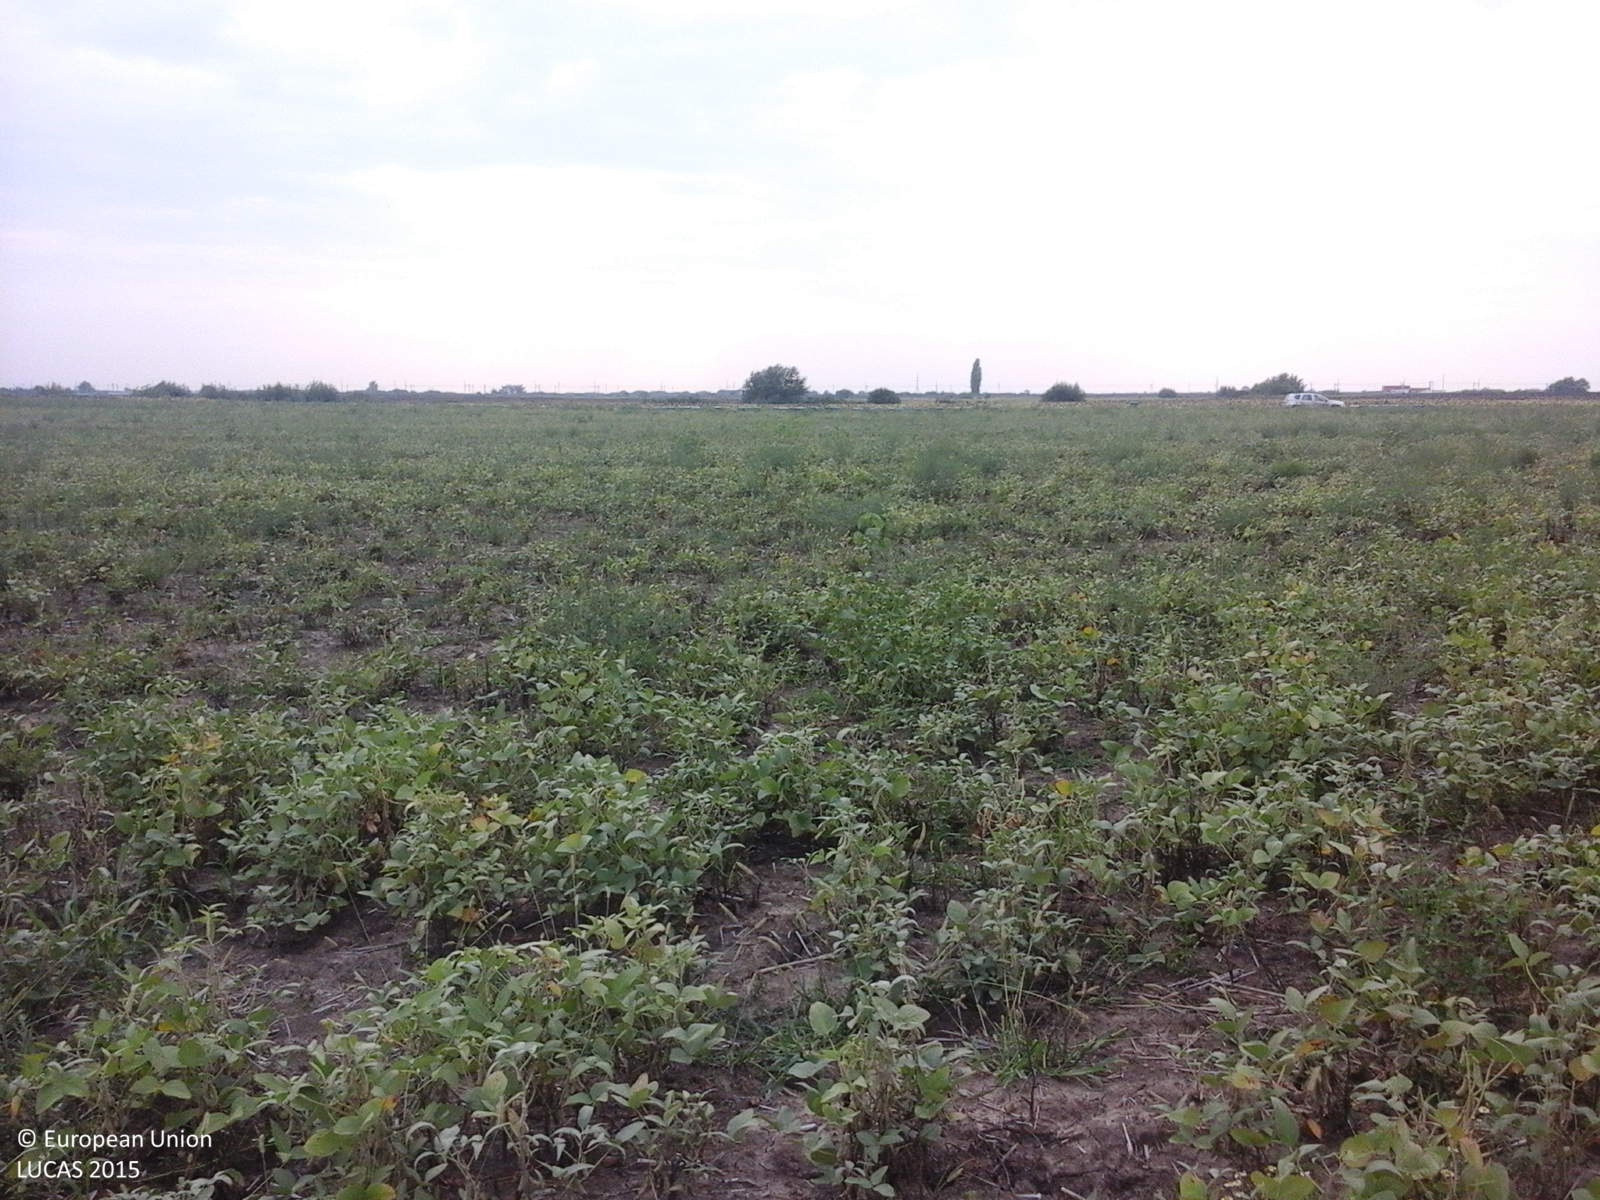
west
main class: Cropland
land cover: Soya
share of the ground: > 75 %
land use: Agriculture (excluding fallow land and kitchen gardens)
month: August
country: RO
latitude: 46.2558
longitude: 21.3334
